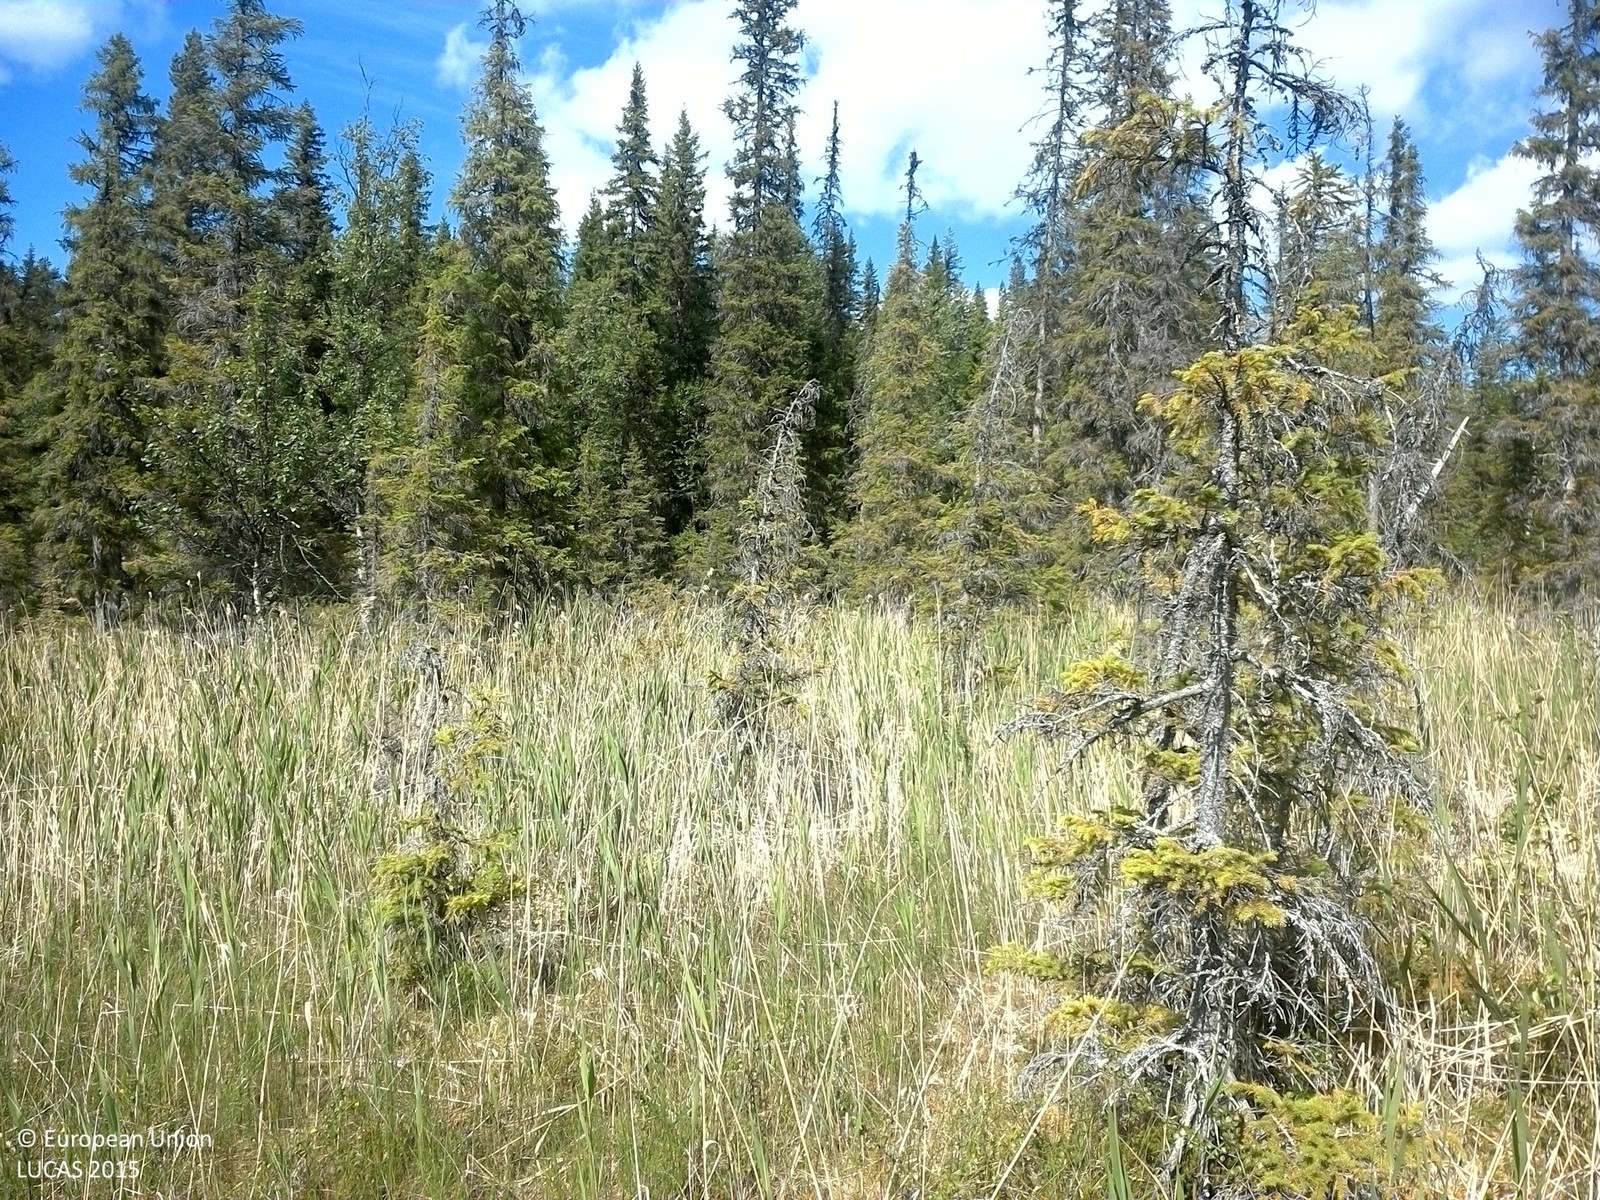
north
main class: Woodland
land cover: Spruce dominated coniferous woodland
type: mire and swamp forests
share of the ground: 10 - 25 %
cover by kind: herbaceous plants 60 %, lichens and mosses 20 %, coniferous forest trees 10 %, shrubs 10 %
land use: Semi-natural and natural areas not in use
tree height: < 5 m
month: July
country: SE
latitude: 64.4727
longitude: 15.8136
